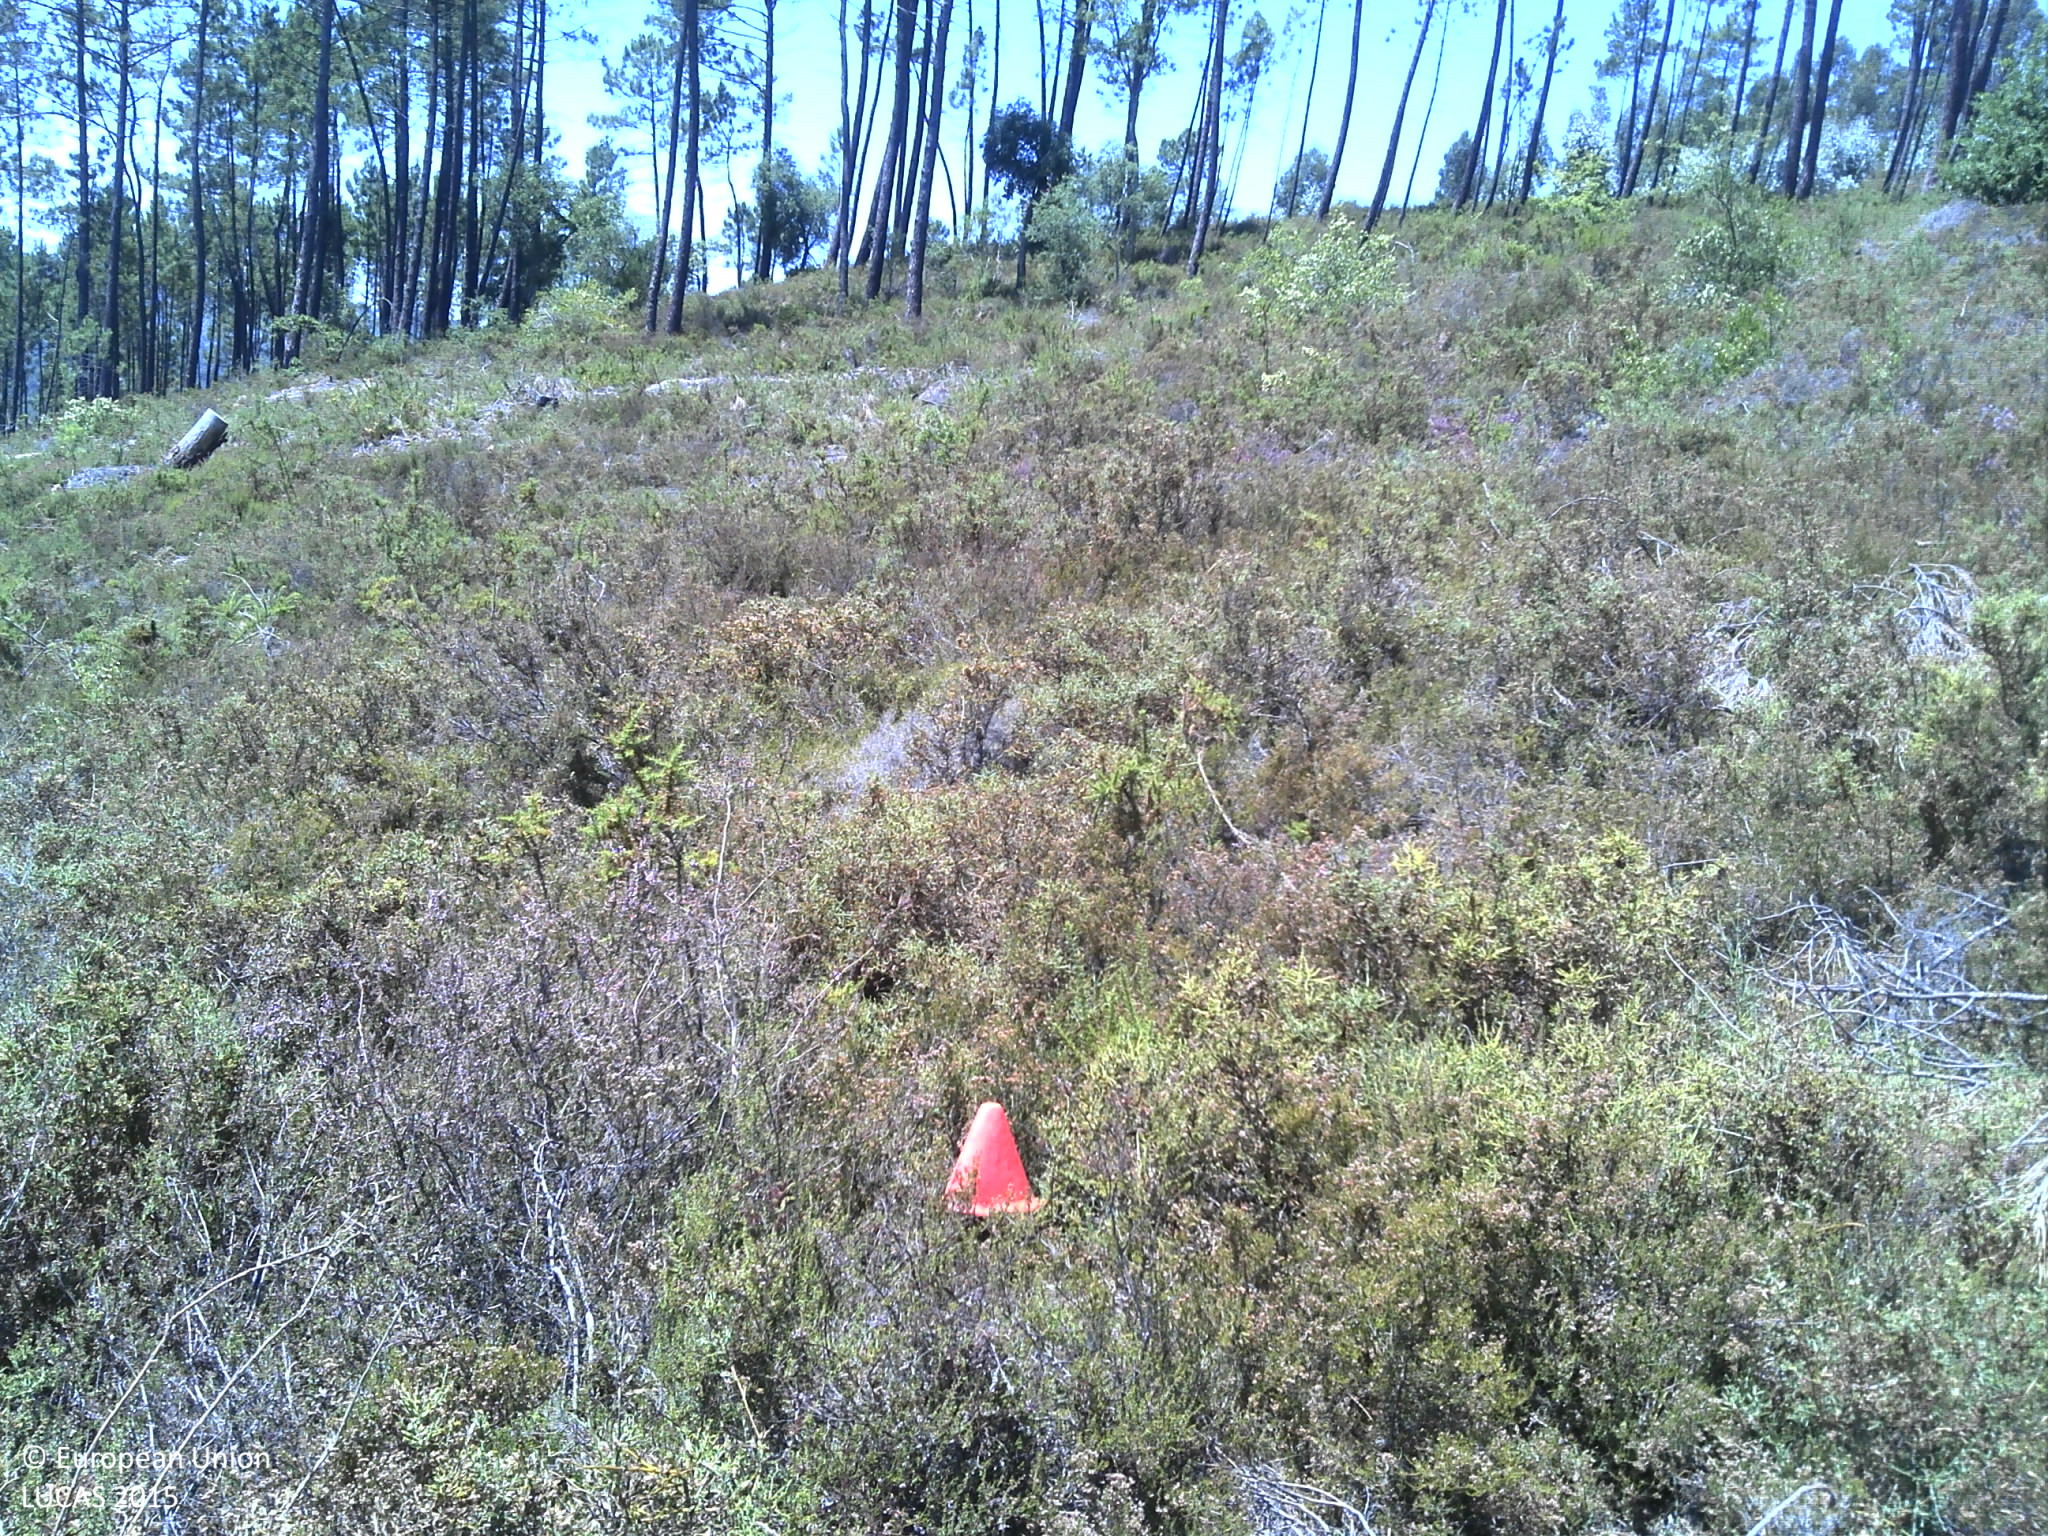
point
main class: Shrubland
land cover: Shrubland without tree cover
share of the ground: > 75 %
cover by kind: shrubs 90 %, unconsolidated bare surface 10 %
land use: Abandoned areas
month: June
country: PT
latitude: 40.1457
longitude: -8.2603
